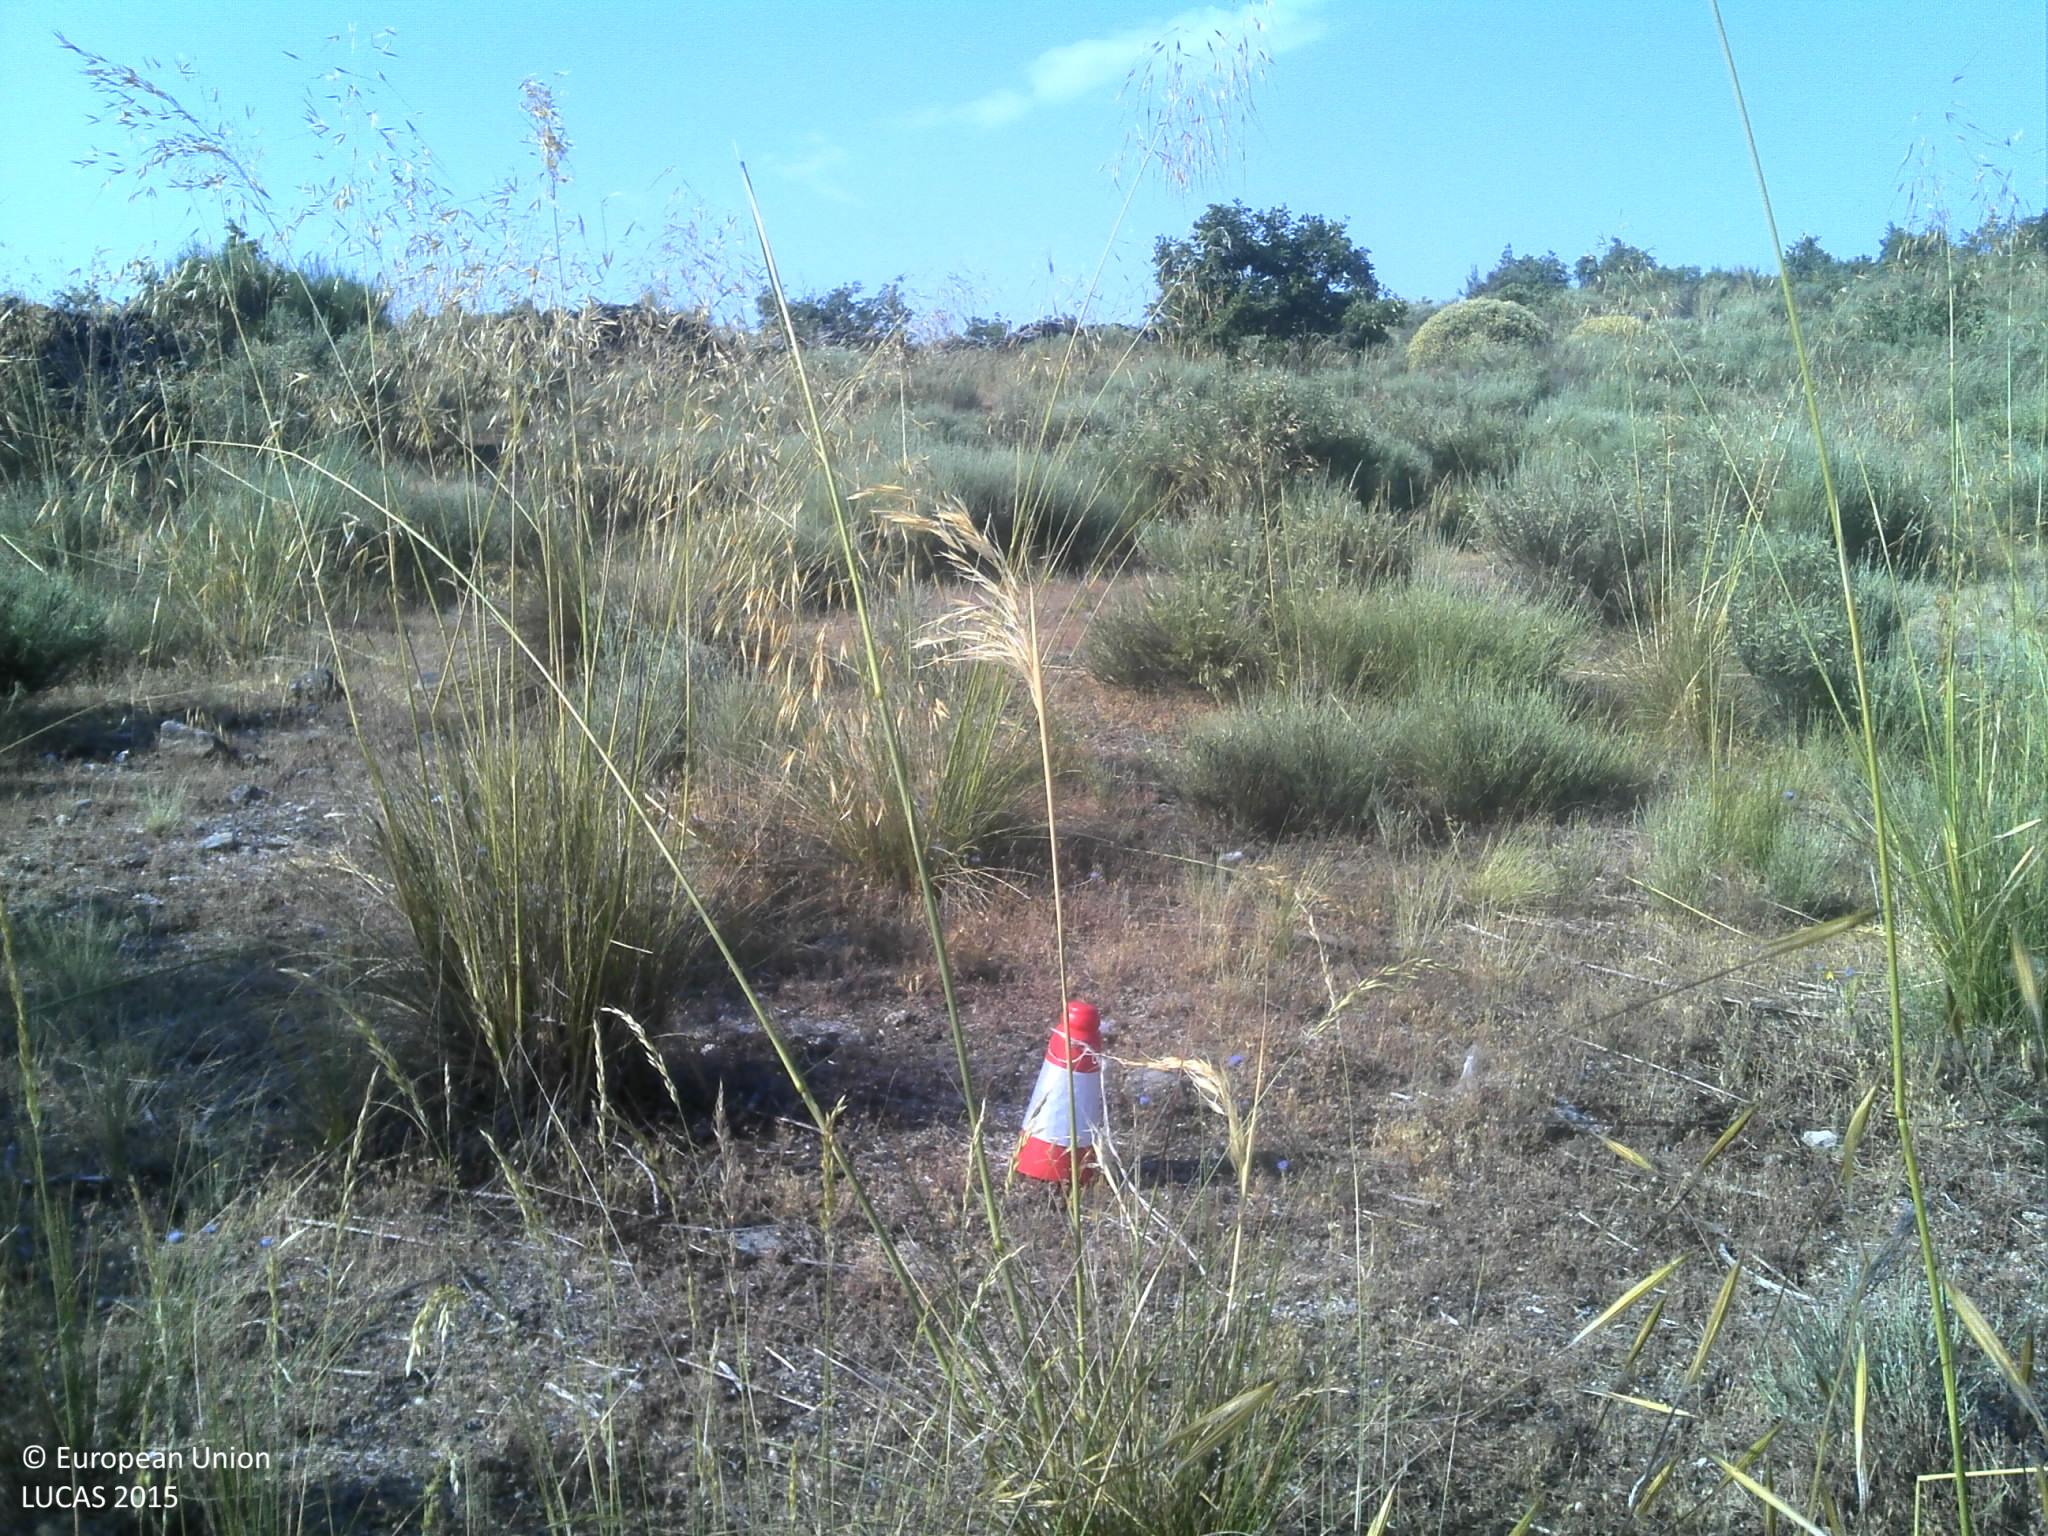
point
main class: Shrubland
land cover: Shrubland without tree cover
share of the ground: 50 - 75 %
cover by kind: shrubs 70 %, herbaceous plants 15 %, unconsolidated bare surface 15 %
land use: Semi-natural and natural areas not in use
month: June
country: PT
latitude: 40.3690
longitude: -7.1412
